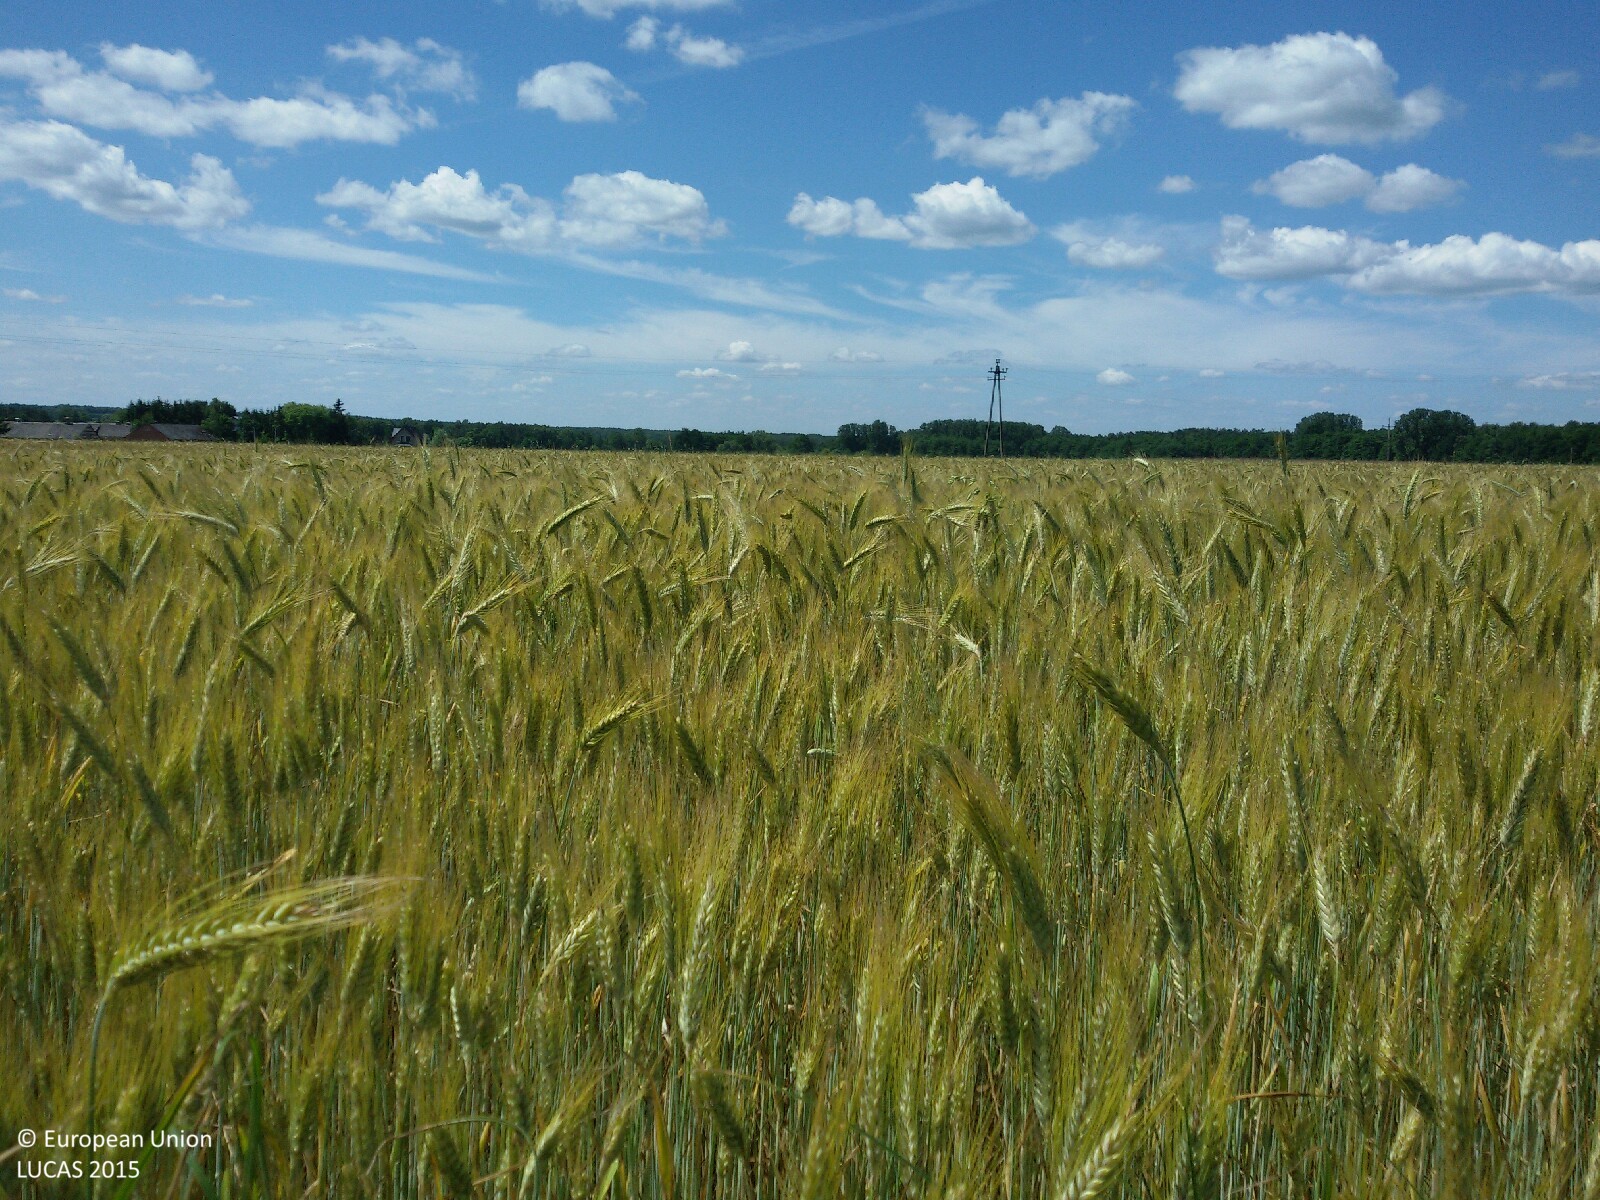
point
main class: Cropland
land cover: Rye
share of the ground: > 75 %
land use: Agriculture (excluding fallow land and kitchen gardens)
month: July
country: PL
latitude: 51.7791
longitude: 21.6929
